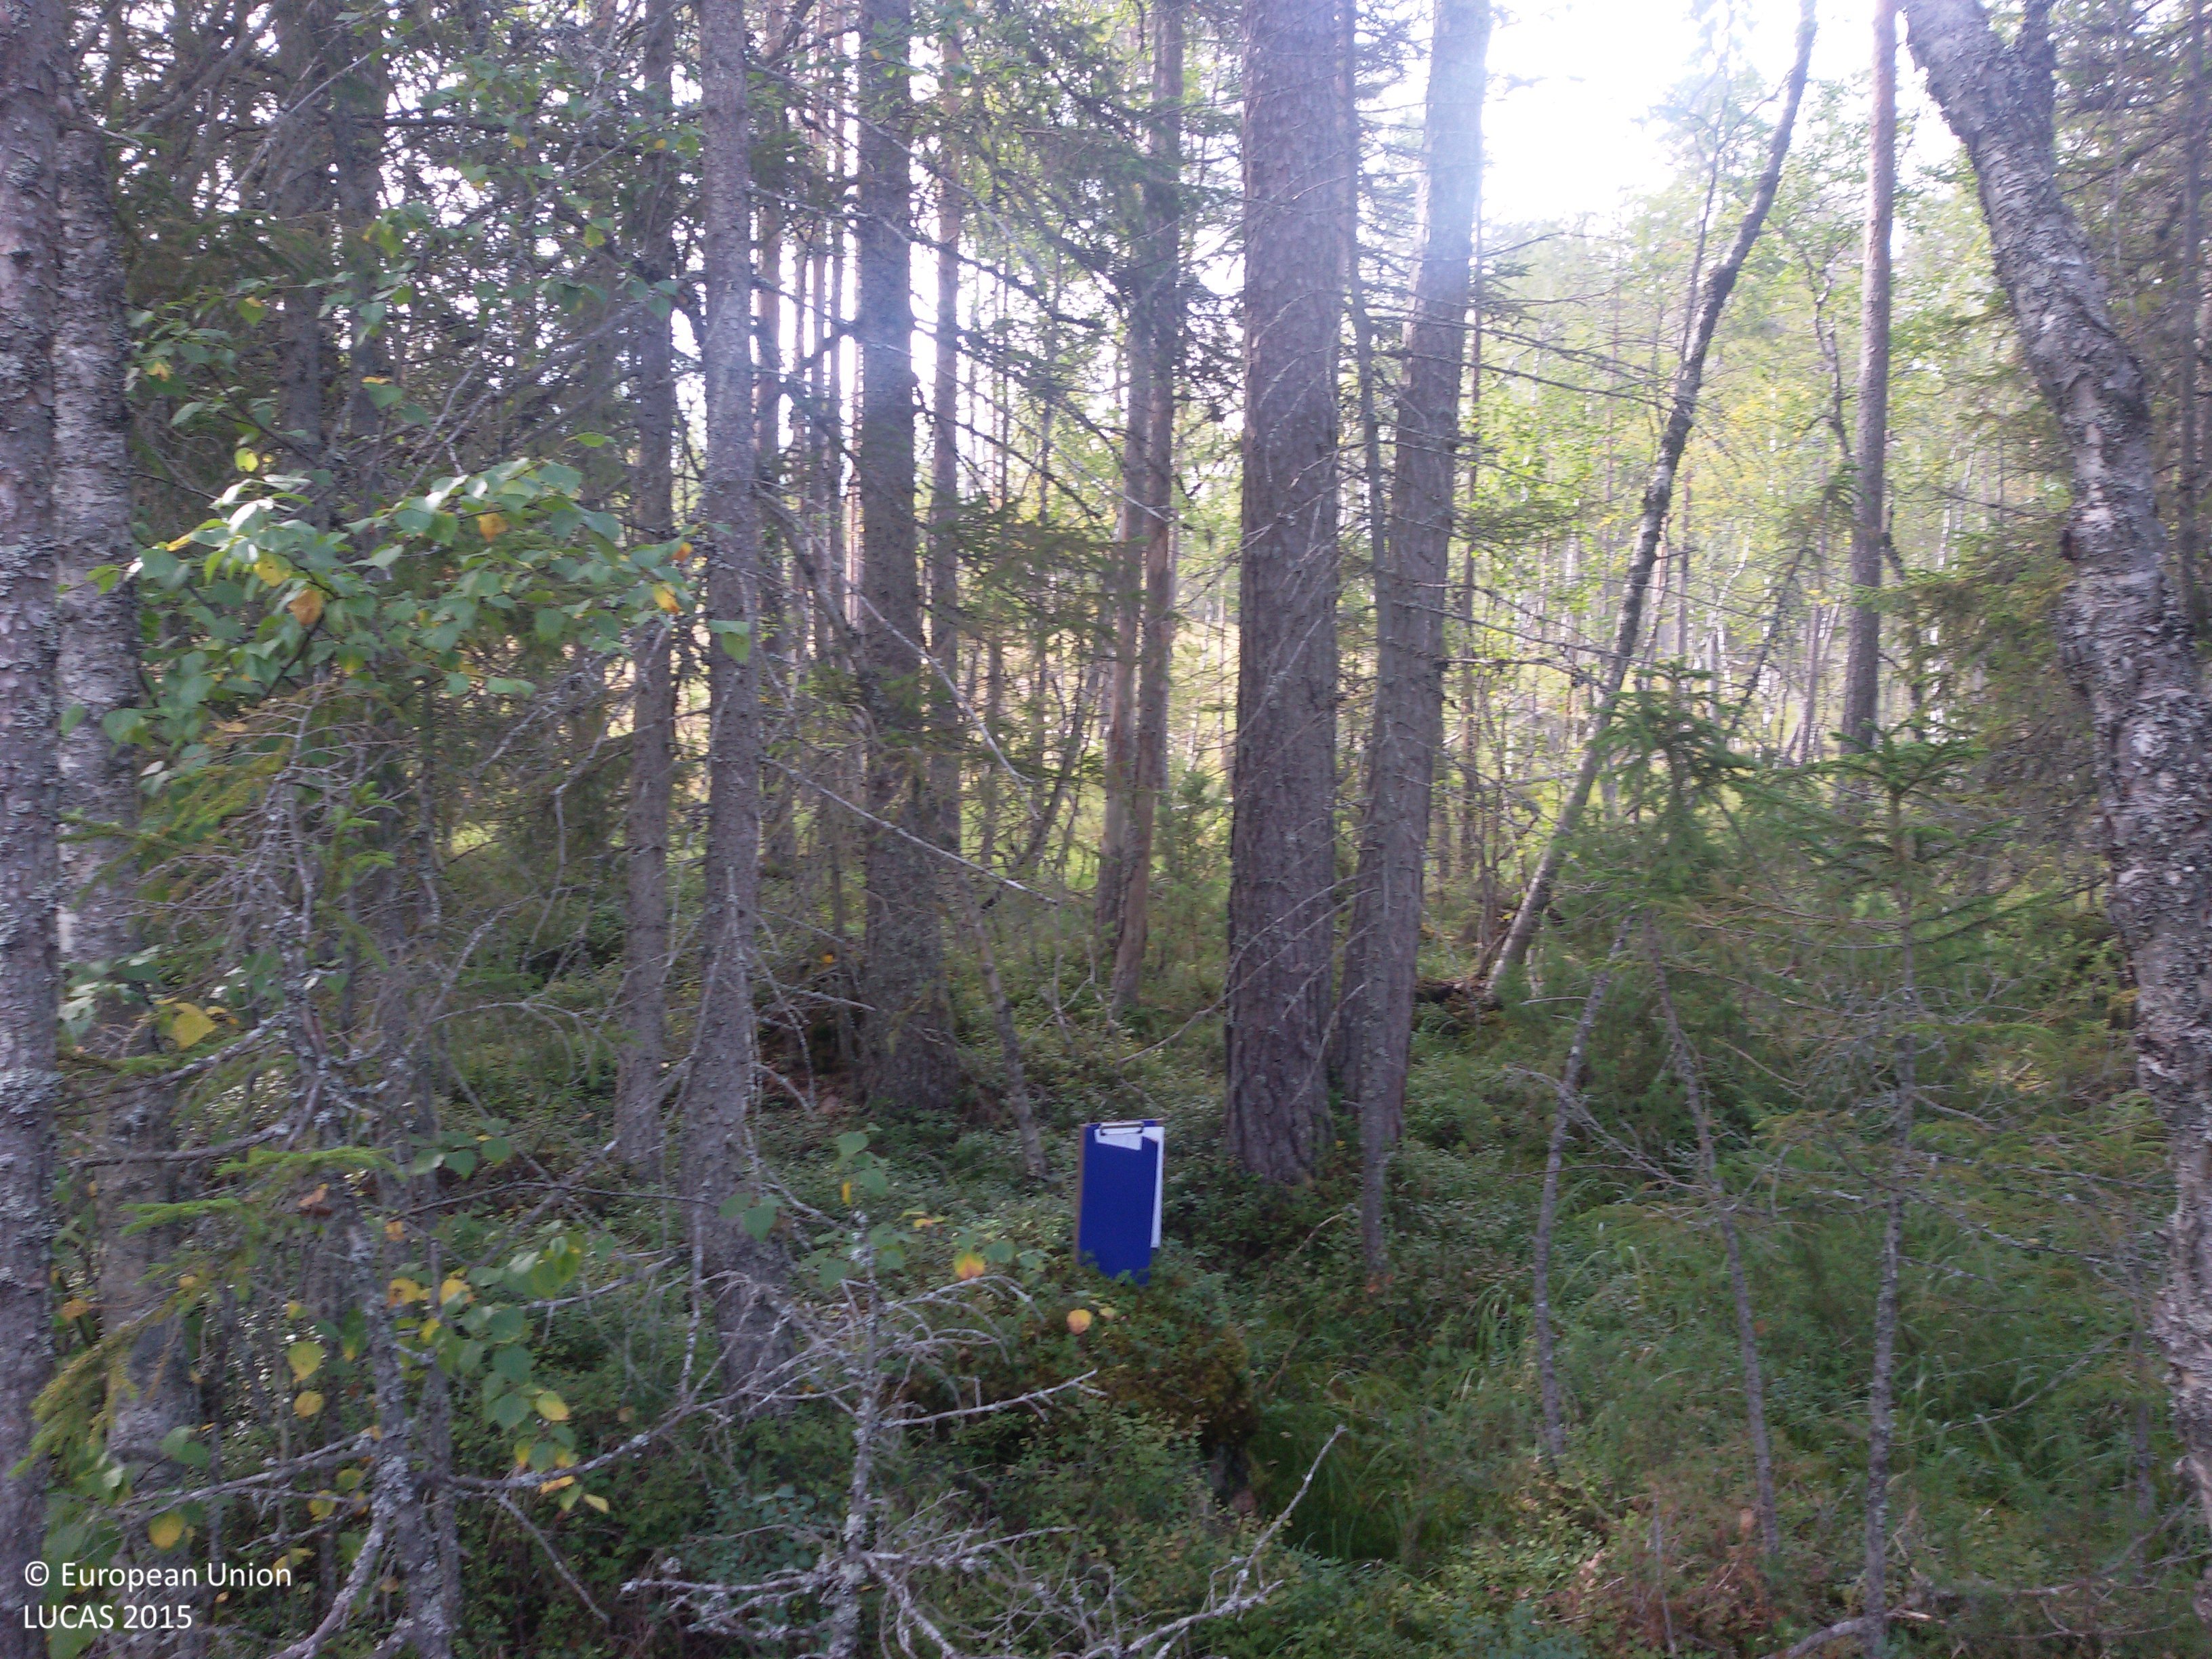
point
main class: Woodland
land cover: Pine dominated mixed woodland
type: boreal forest
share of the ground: 50 - 75 %
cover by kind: coniferous forest trees 45 %, broadleaved forest trees 25 %, herbaceous plants 15 %, lichens and mosses 15 %
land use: Forestry
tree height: > 5 m
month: September
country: SE
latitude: 60.8695
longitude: 15.4557
